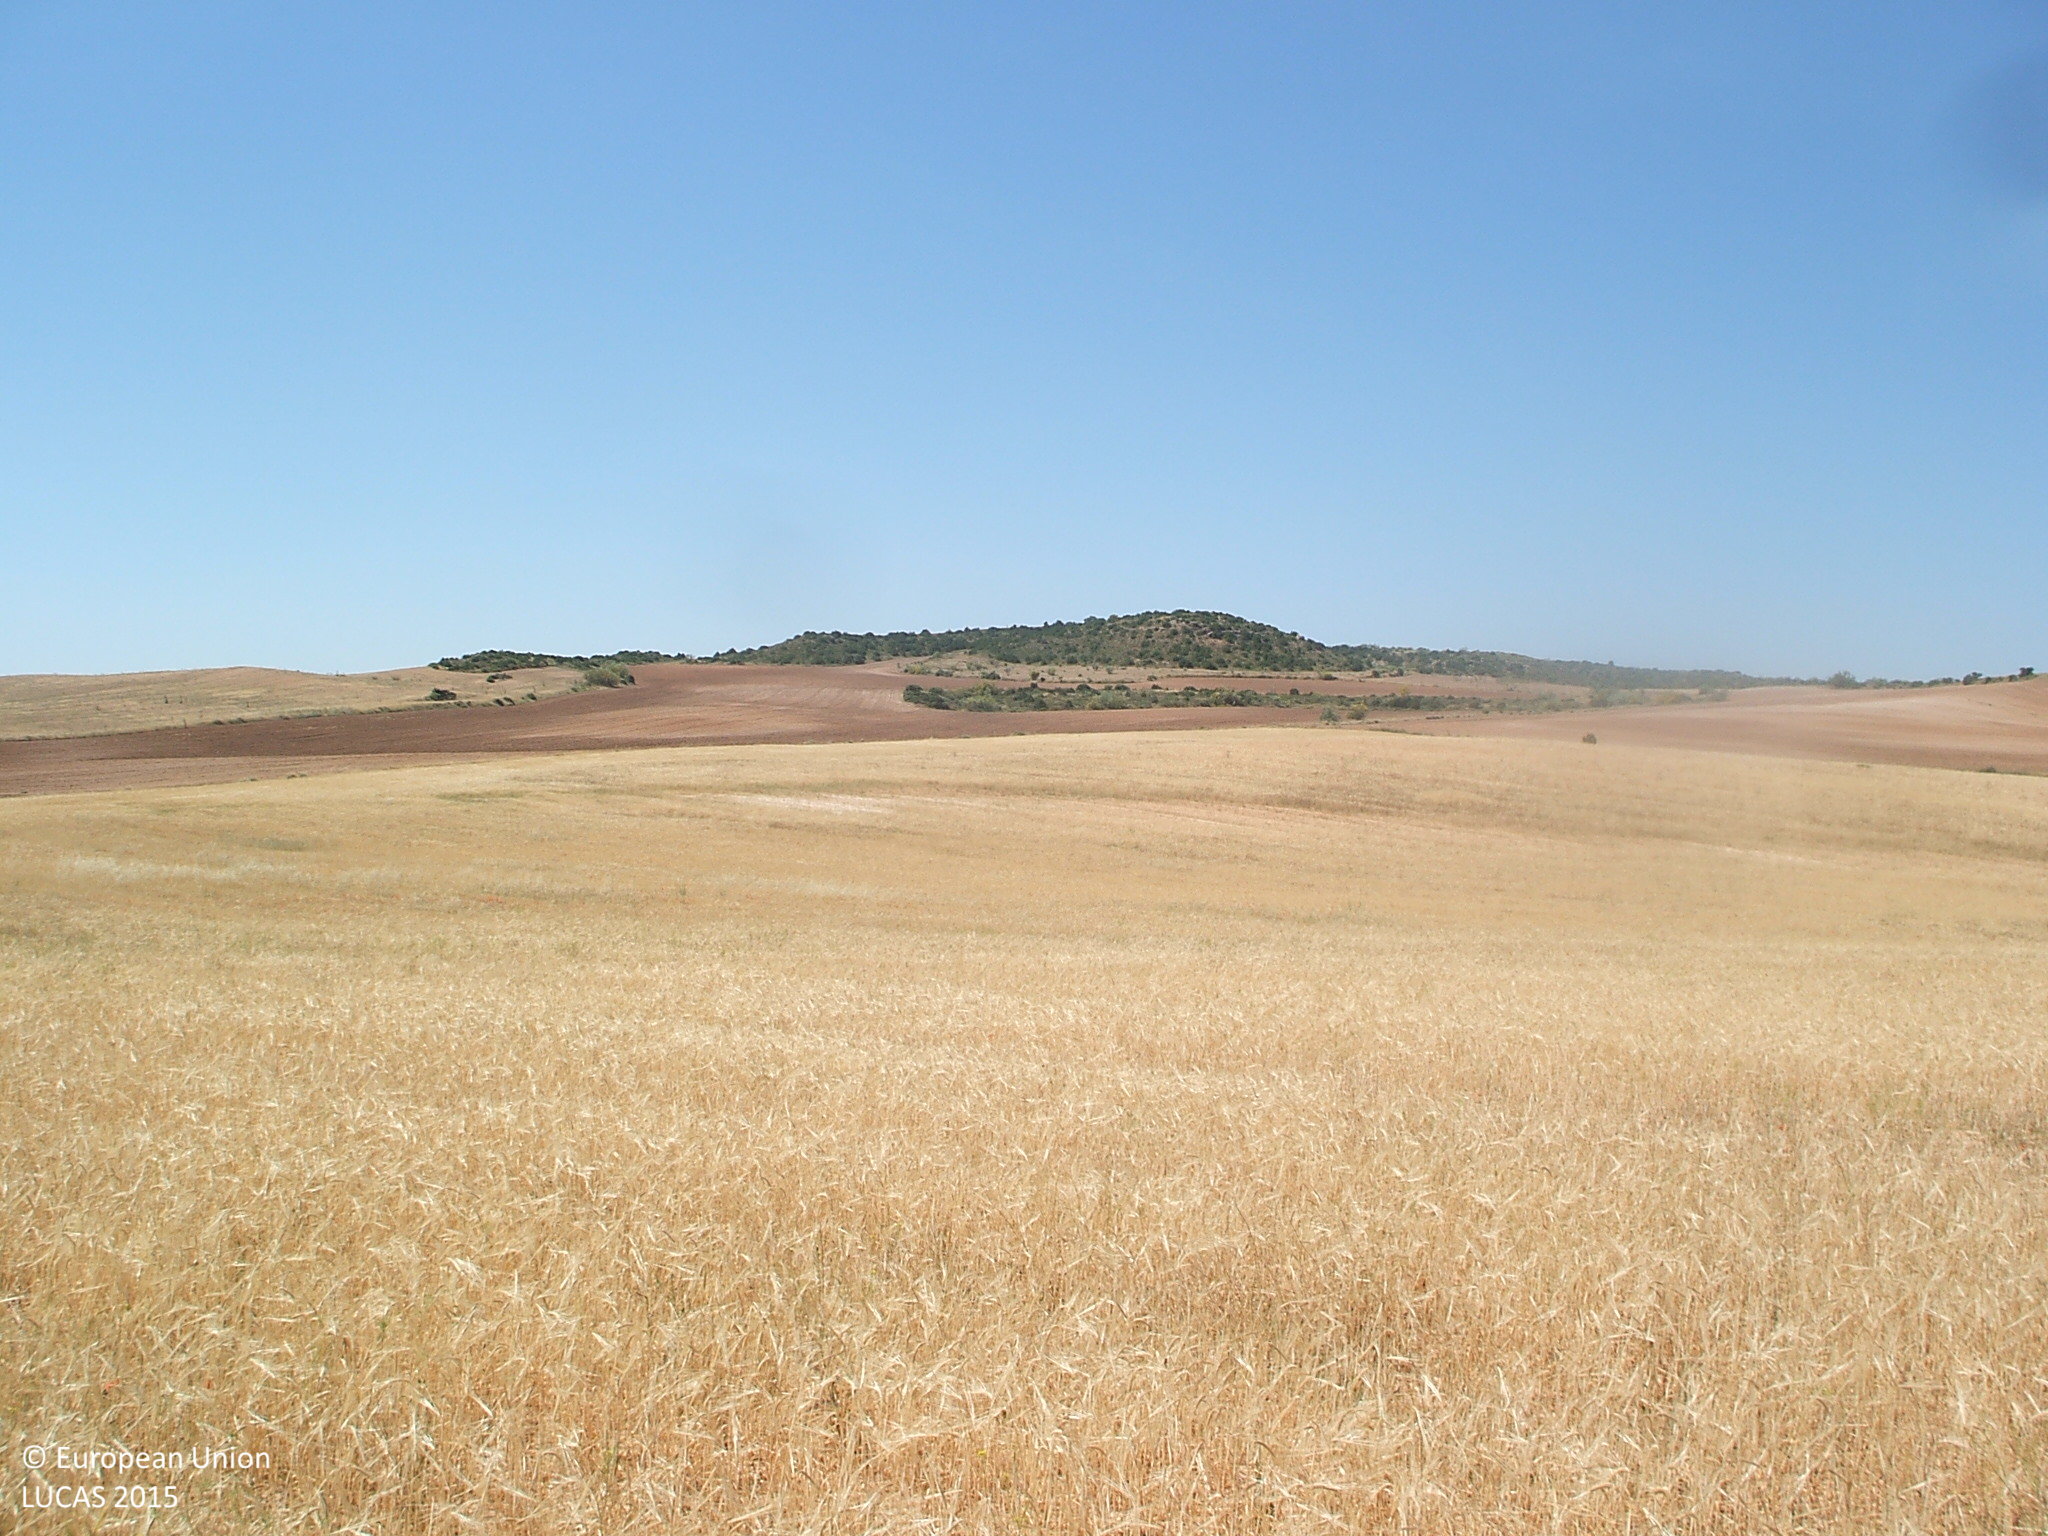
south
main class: Cropland
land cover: Barley
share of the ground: > 75 %
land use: Agriculture (excluding fallow land and kitchen gardens)
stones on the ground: > 50 %
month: June
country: ES
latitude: 41.0508
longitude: -0.3278
